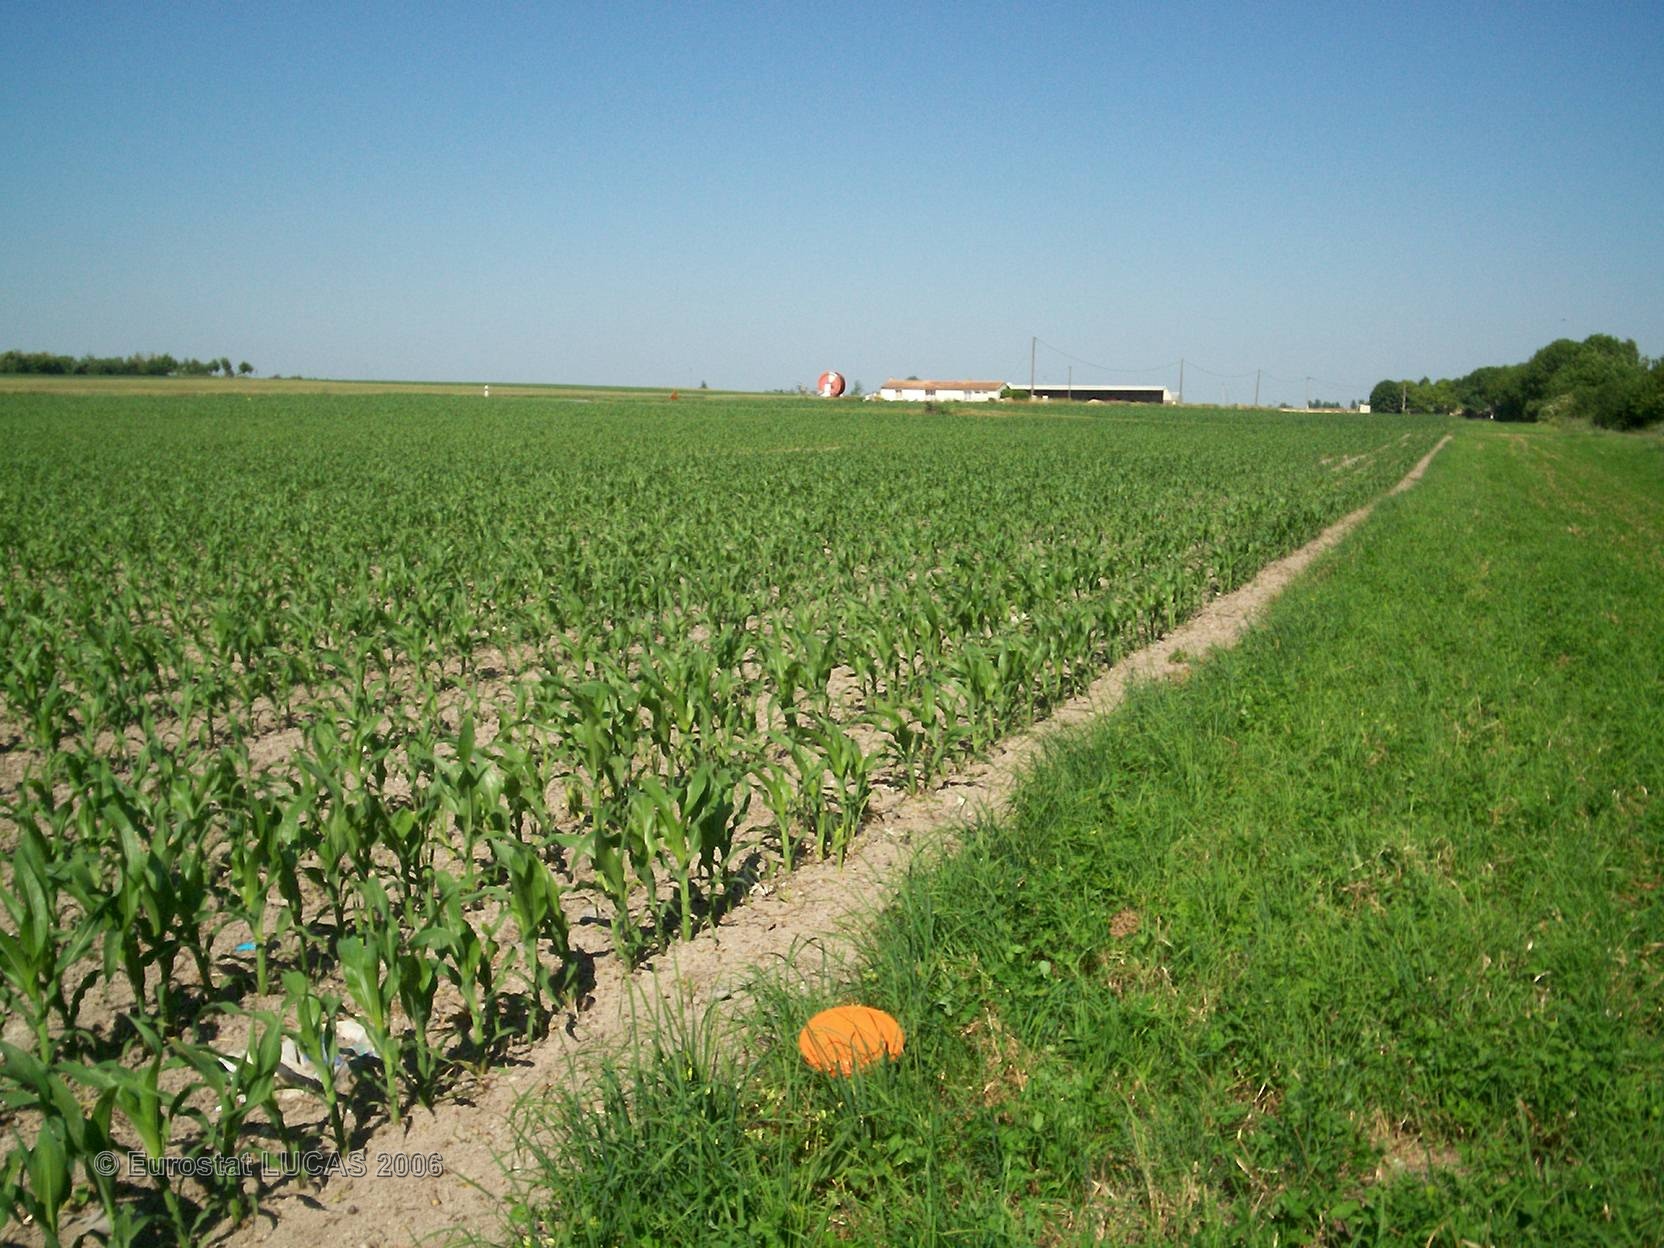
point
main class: Grassland
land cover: Grassland with sparse tree/shrub cover
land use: Fallow land
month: June
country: FR
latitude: 46.2282
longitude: -0.7243
